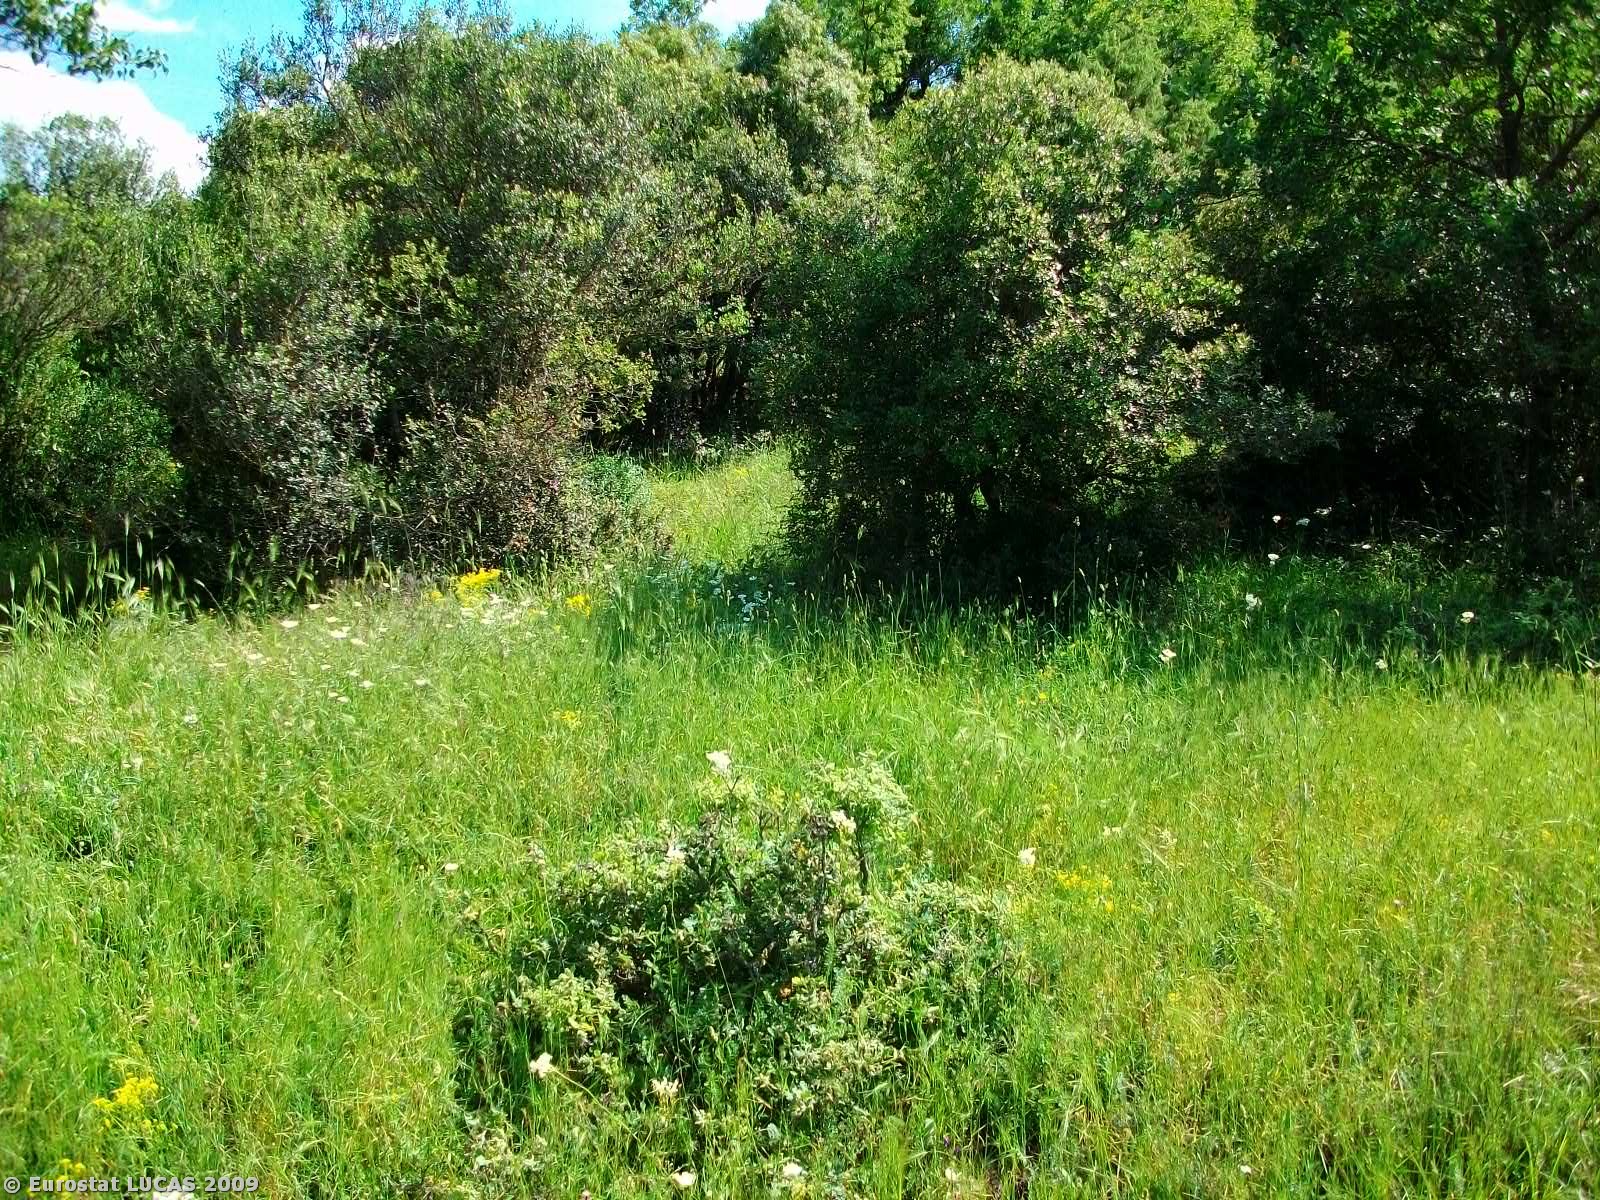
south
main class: Woodland
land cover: Broadleaved woodland
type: thermophilous deciduous forest
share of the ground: > 75 %
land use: Forestry
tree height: > 5 m
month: June
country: GR
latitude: 40.0109
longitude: 21.7858
